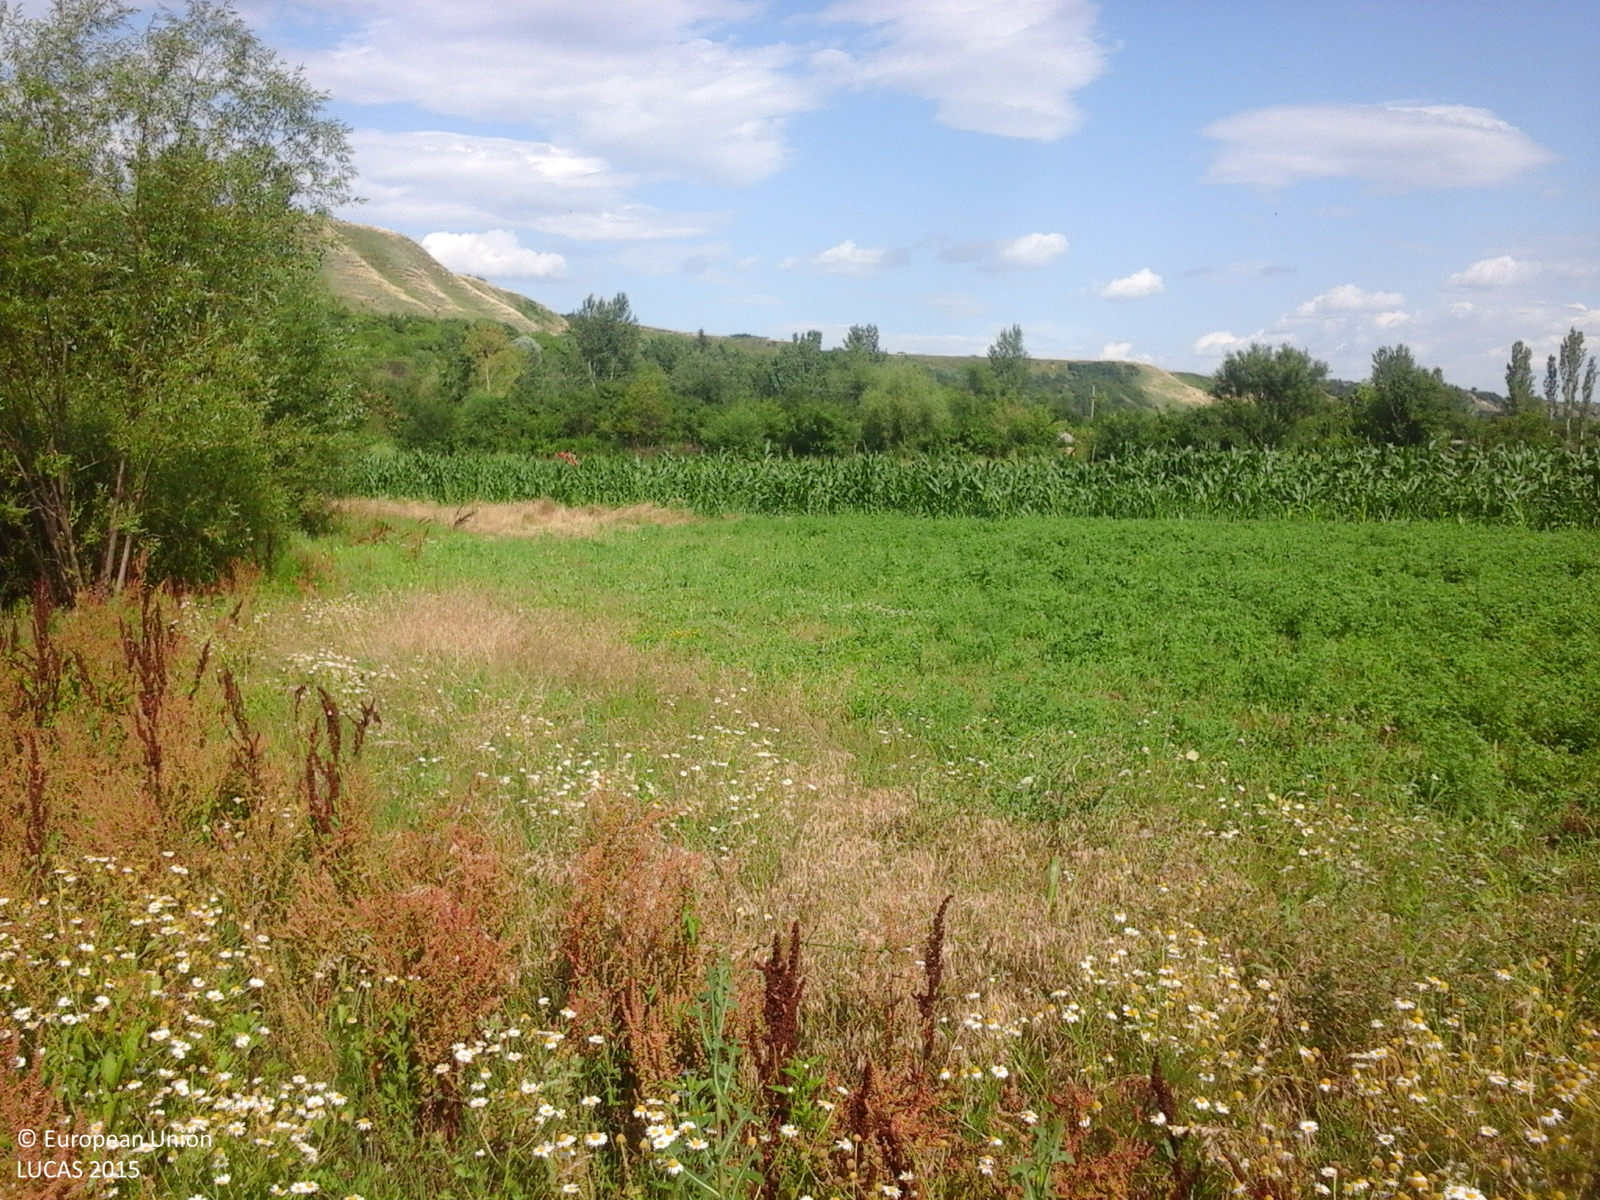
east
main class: Grassland
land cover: Grassland without tree/shrub cover
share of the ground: > 75 %
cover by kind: herbaceous plants 100 %
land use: Agriculture (excluding fallow land and kitchen gardens)
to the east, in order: Grassland without tree/shrub cover; Lucerne; Maize; Other fresh vegetables; Lucerne; Fences; Spontaneously vegetated surfaces; Electric lines; Abandoned hedges; Arable land (only in case pi); Tracks; Abandoned hedges; Inland fresh running water; Abandoned hedges; Artificial constructions in urban areas
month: July
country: RO
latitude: 44.0566
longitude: 24.6370
